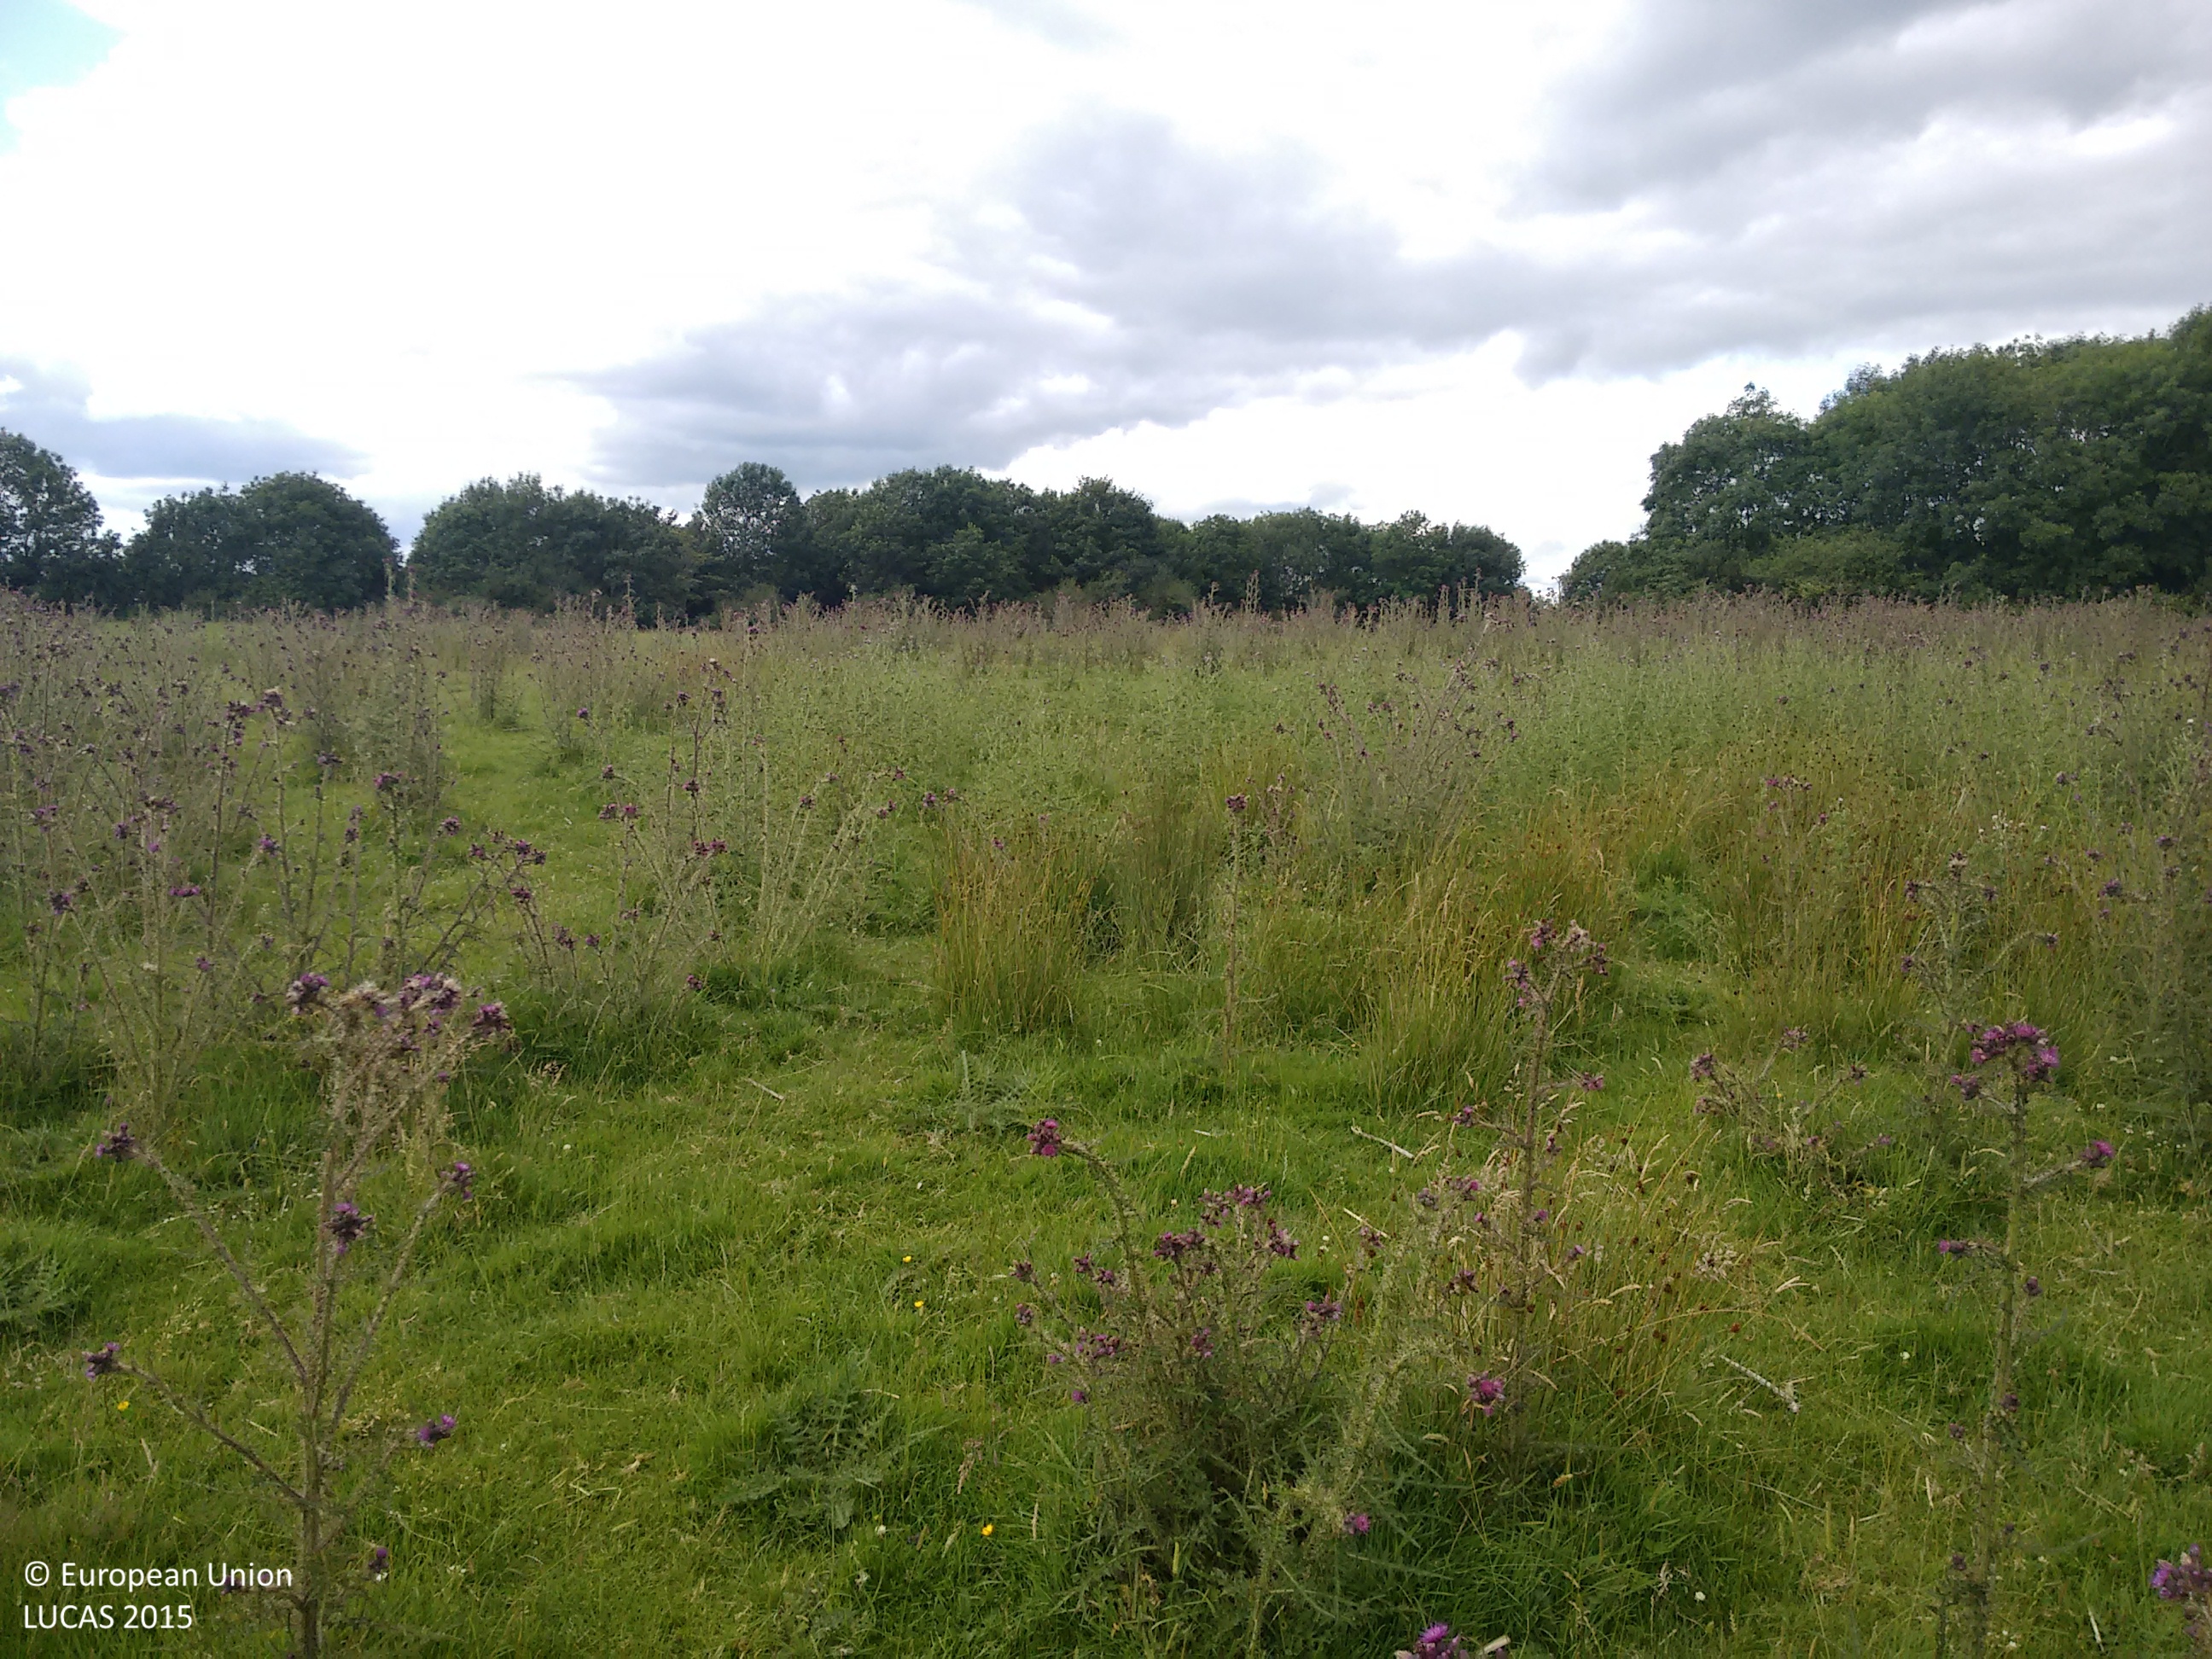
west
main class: Grassland
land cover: Grassland without tree/shrub cover
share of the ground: > 75 %
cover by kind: herbaceous plants 95 %, shrubs 5 %
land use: Agriculture (excluding fallow land and kitchen gardens)
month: July
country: IE
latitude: 53.5544
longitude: -7.8456
